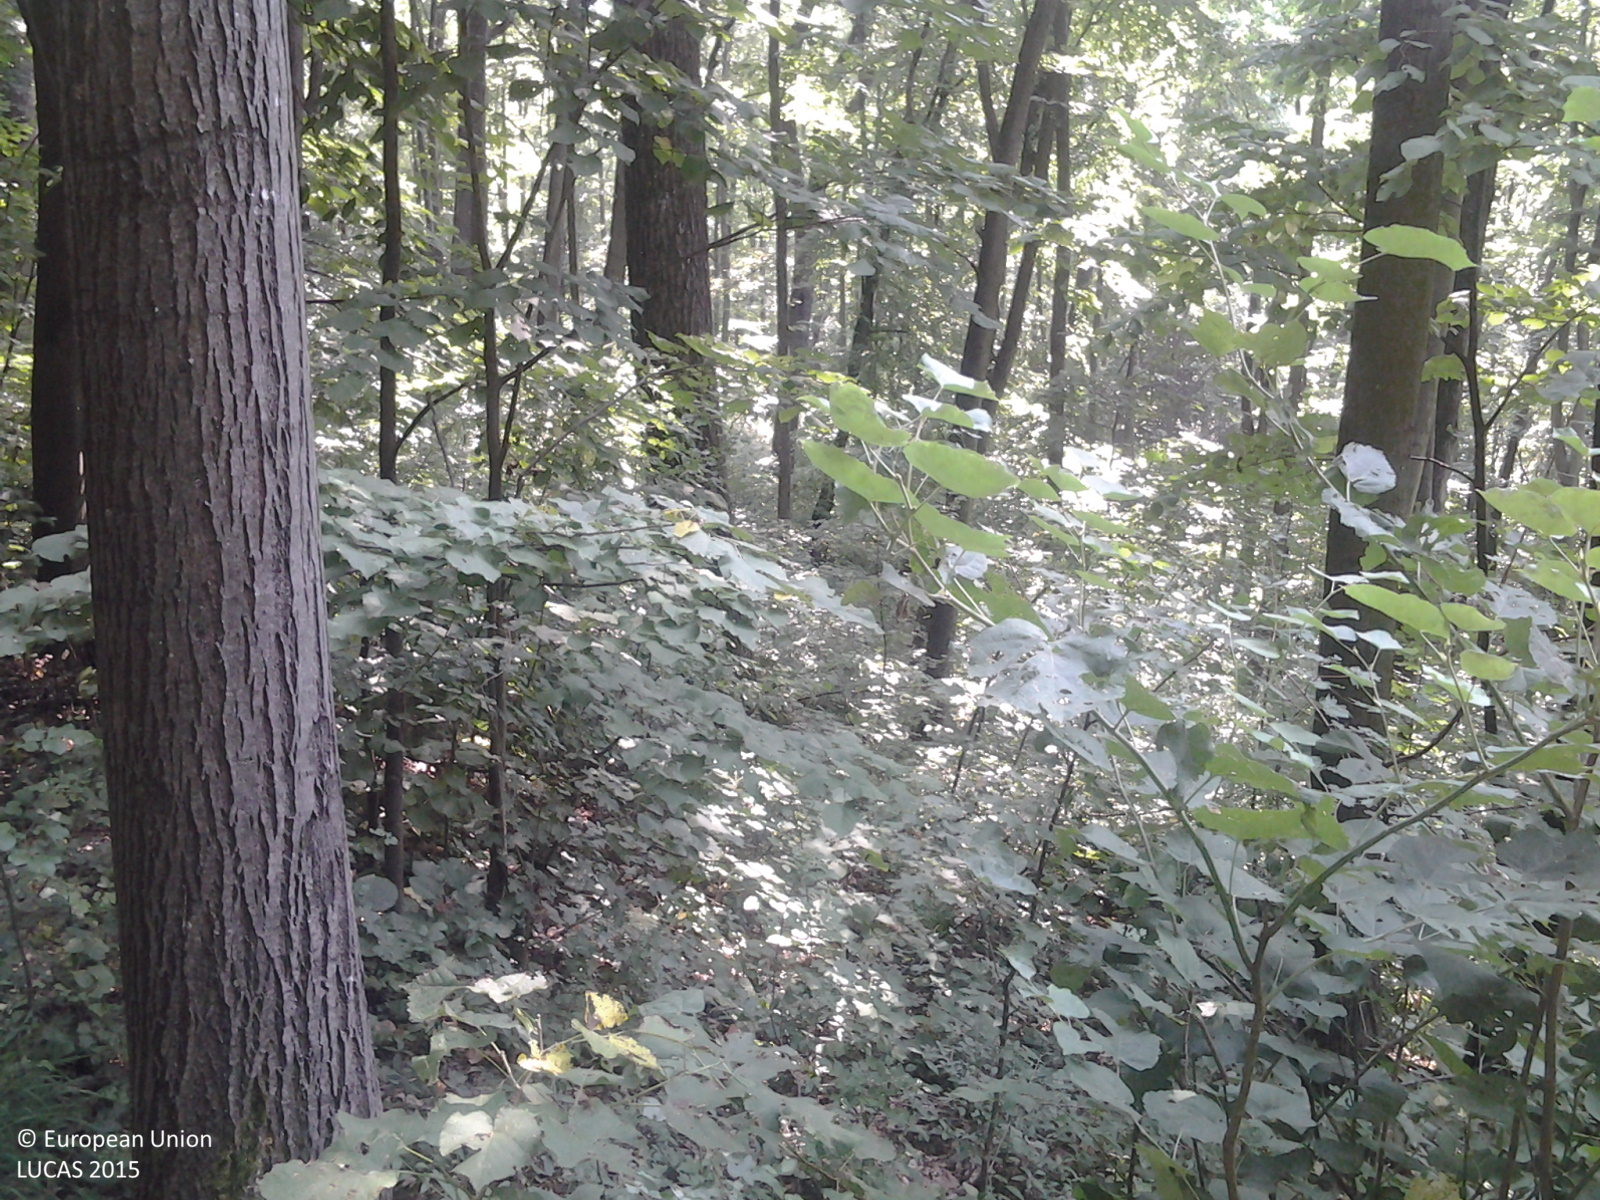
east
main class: Woodland
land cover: Broadleaved woodland
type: mesophytic deciduous forest
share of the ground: > 75 %
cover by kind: broadleaved forest trees 75 %, shrubs 25 %
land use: Forestry
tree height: > 5 m
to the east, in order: Broadleaved woodland
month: August
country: HU
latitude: 46.2545
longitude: 17.6974
